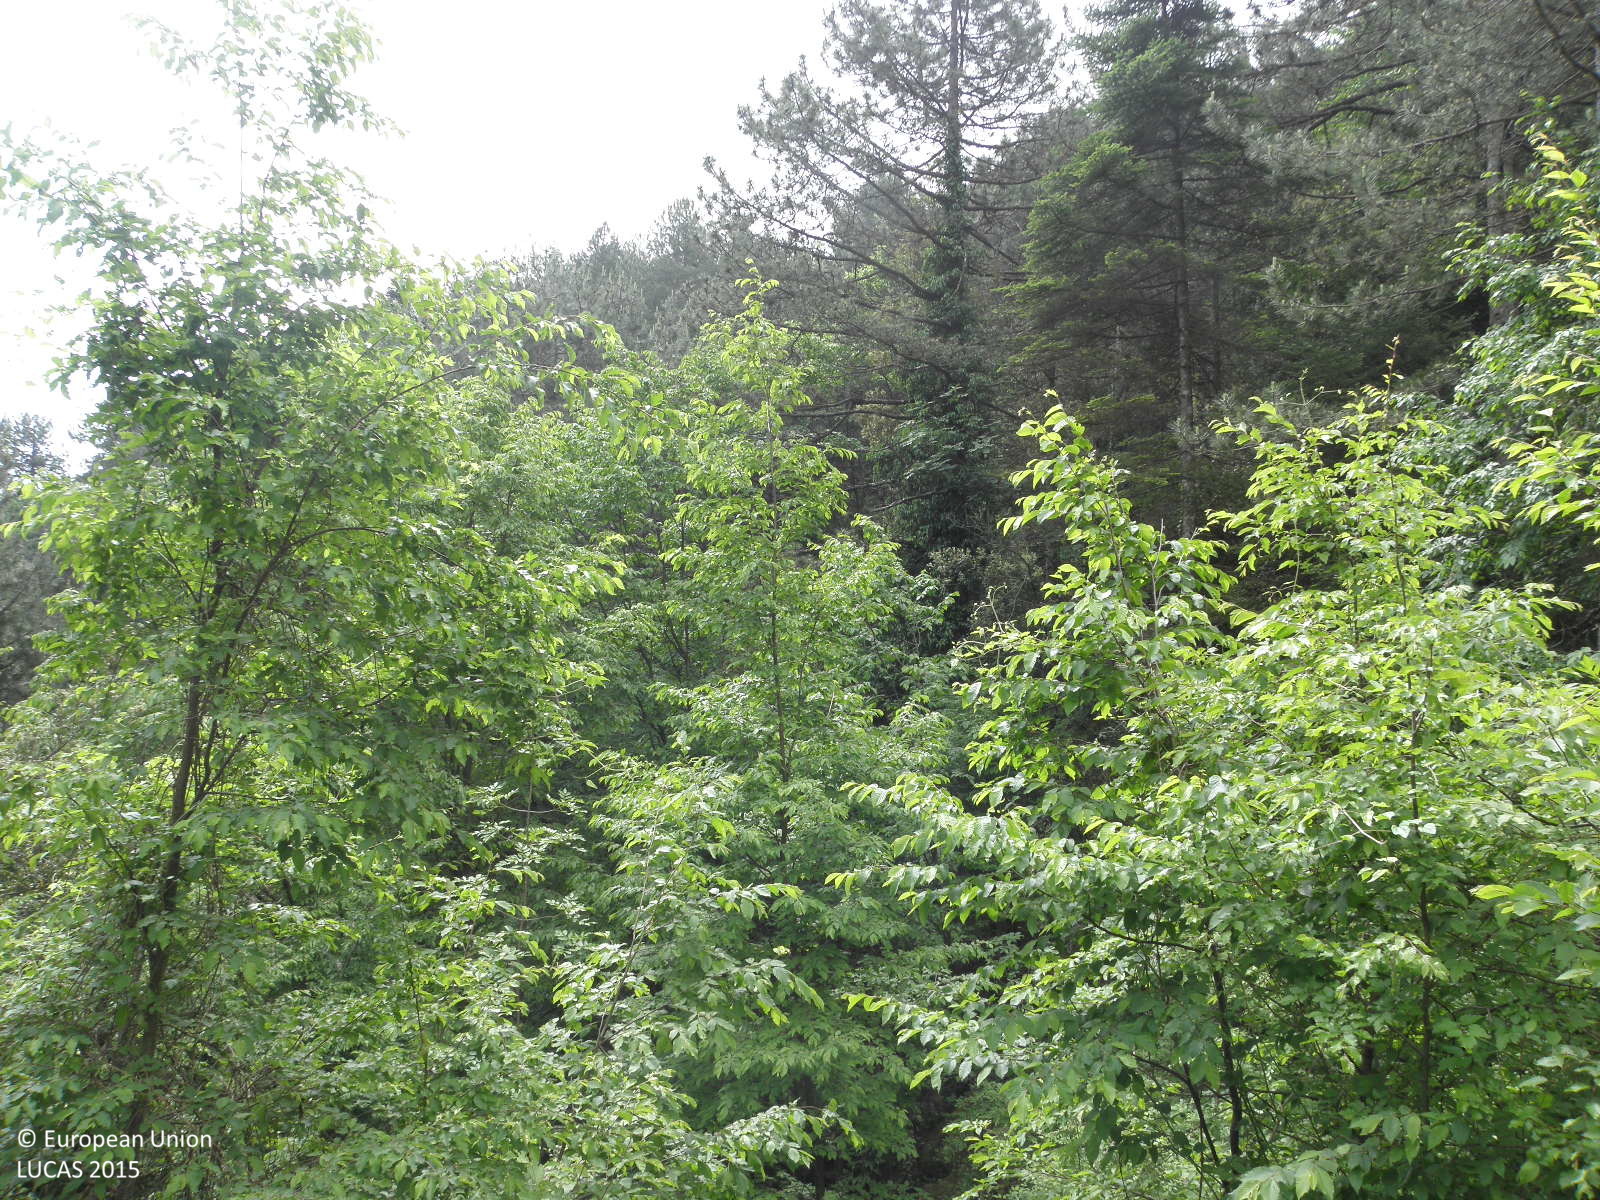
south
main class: Woodland
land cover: Pine dominated coniferous woodland
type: coniferous forest of the mediterranean region
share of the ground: > 75 %
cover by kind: coniferous forest trees 90 %, broadleaved forest trees 10 %
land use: Forestry
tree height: > 5 m
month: May
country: GR
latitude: 40.0879
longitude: 22.4865
